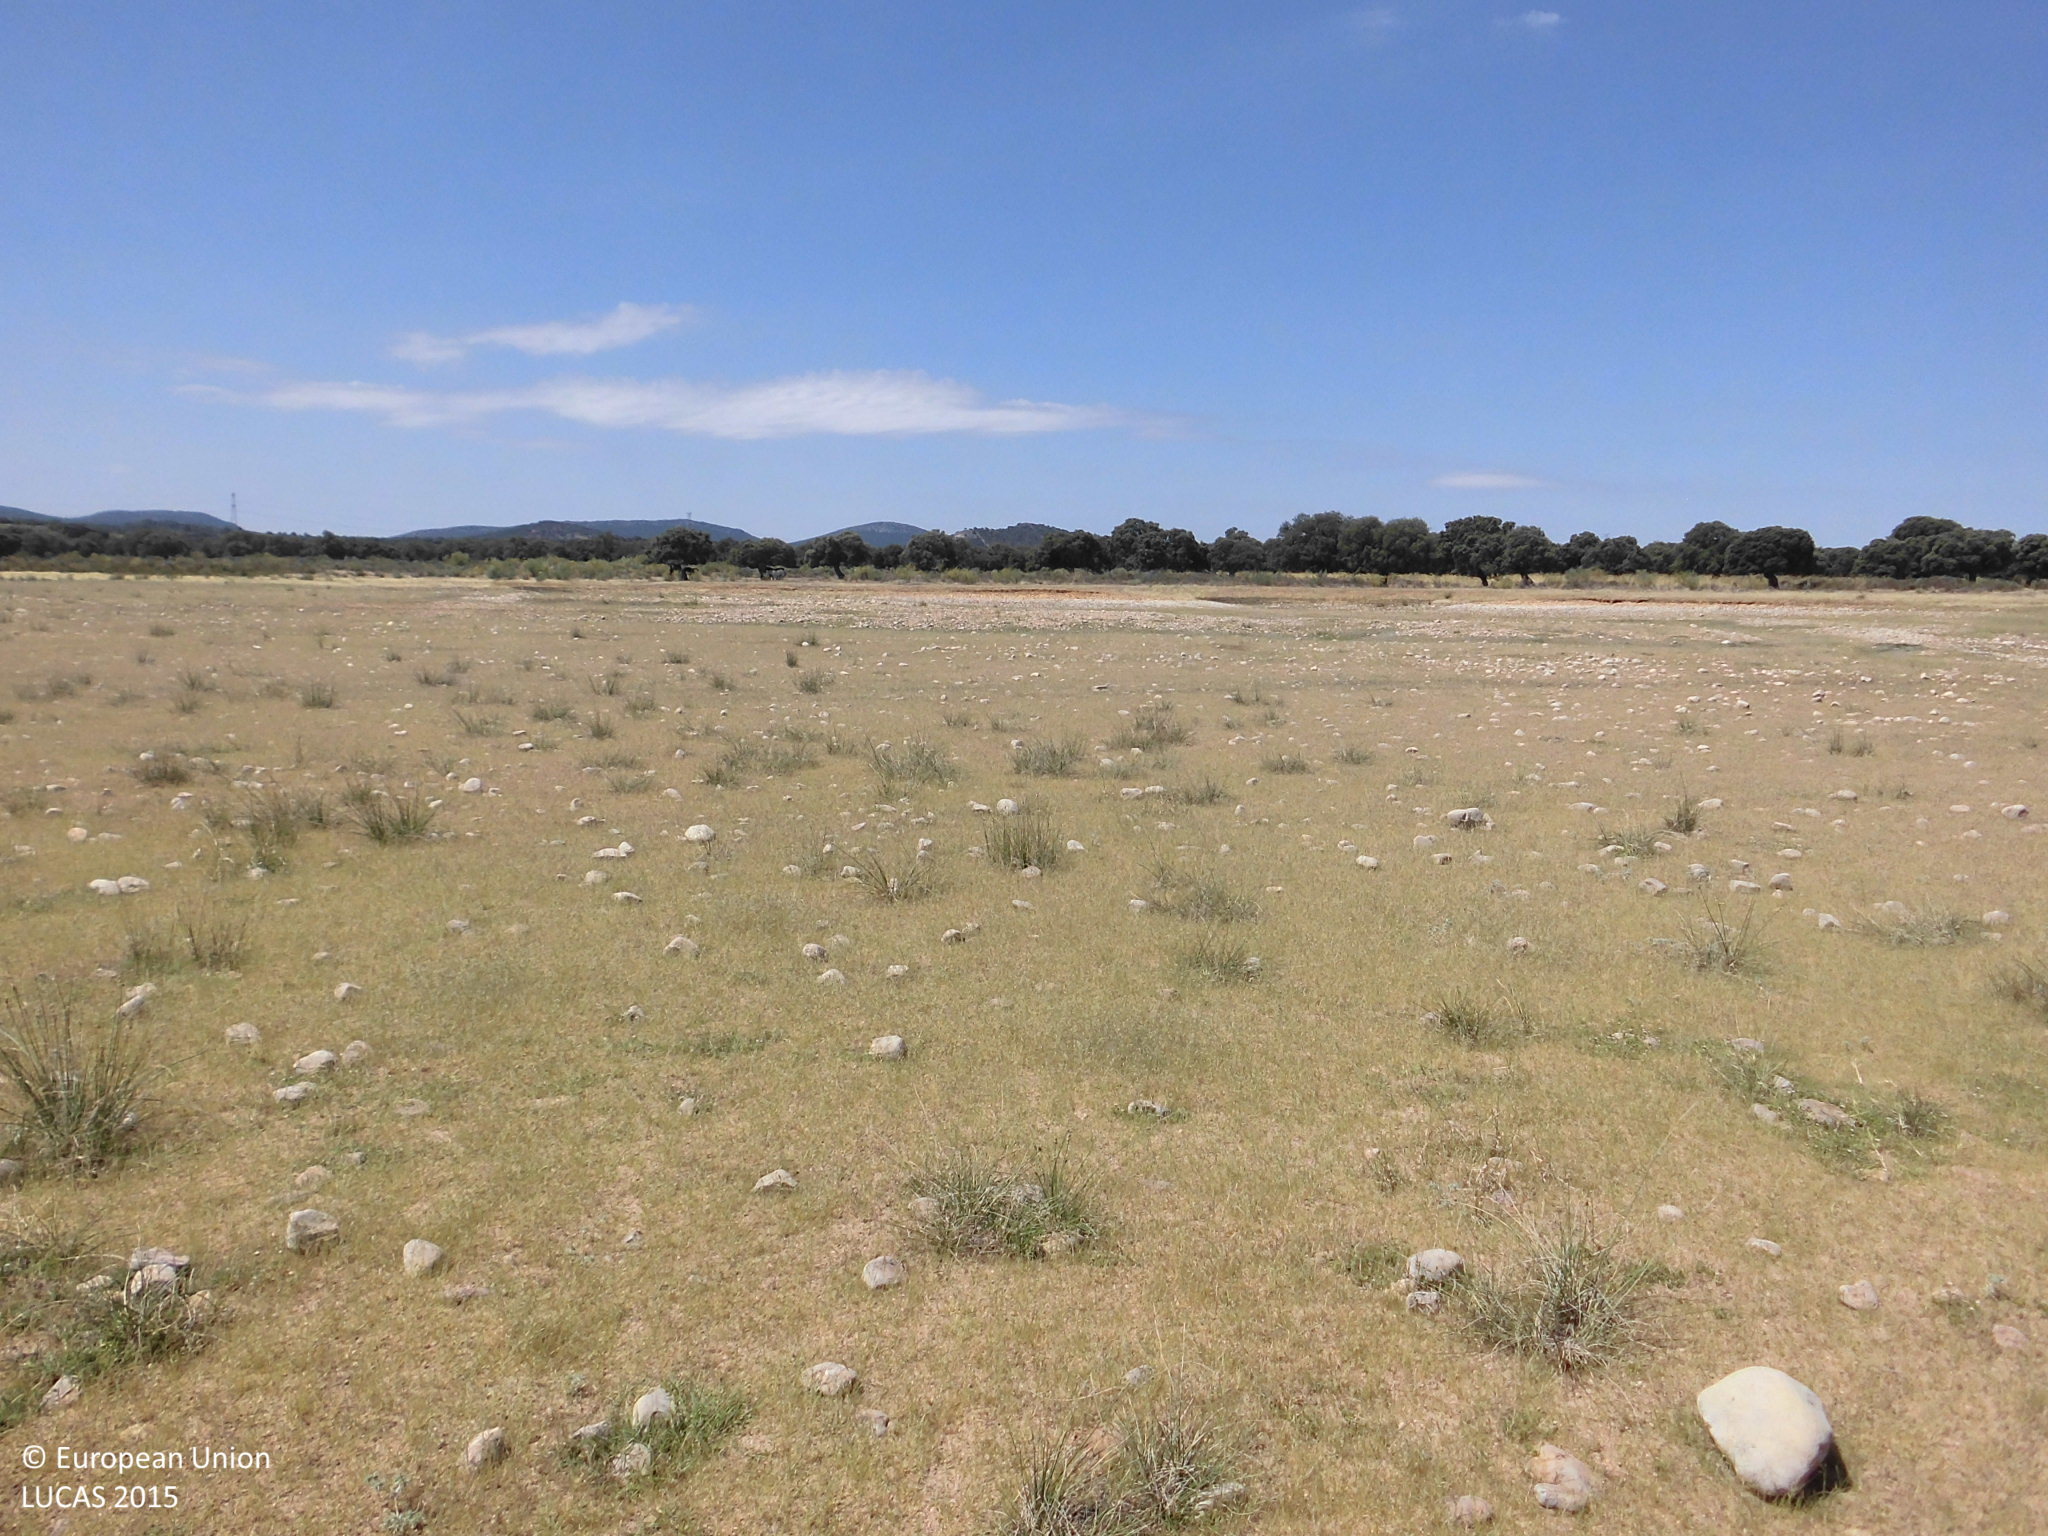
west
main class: Grassland
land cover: Spontaneously vegetated surfaces
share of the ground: > 75 %
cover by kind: herbaceous plants 100 %
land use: Semi-natural and natural areas not in use
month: July
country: ES
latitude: 39.7876
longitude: -5.4579
